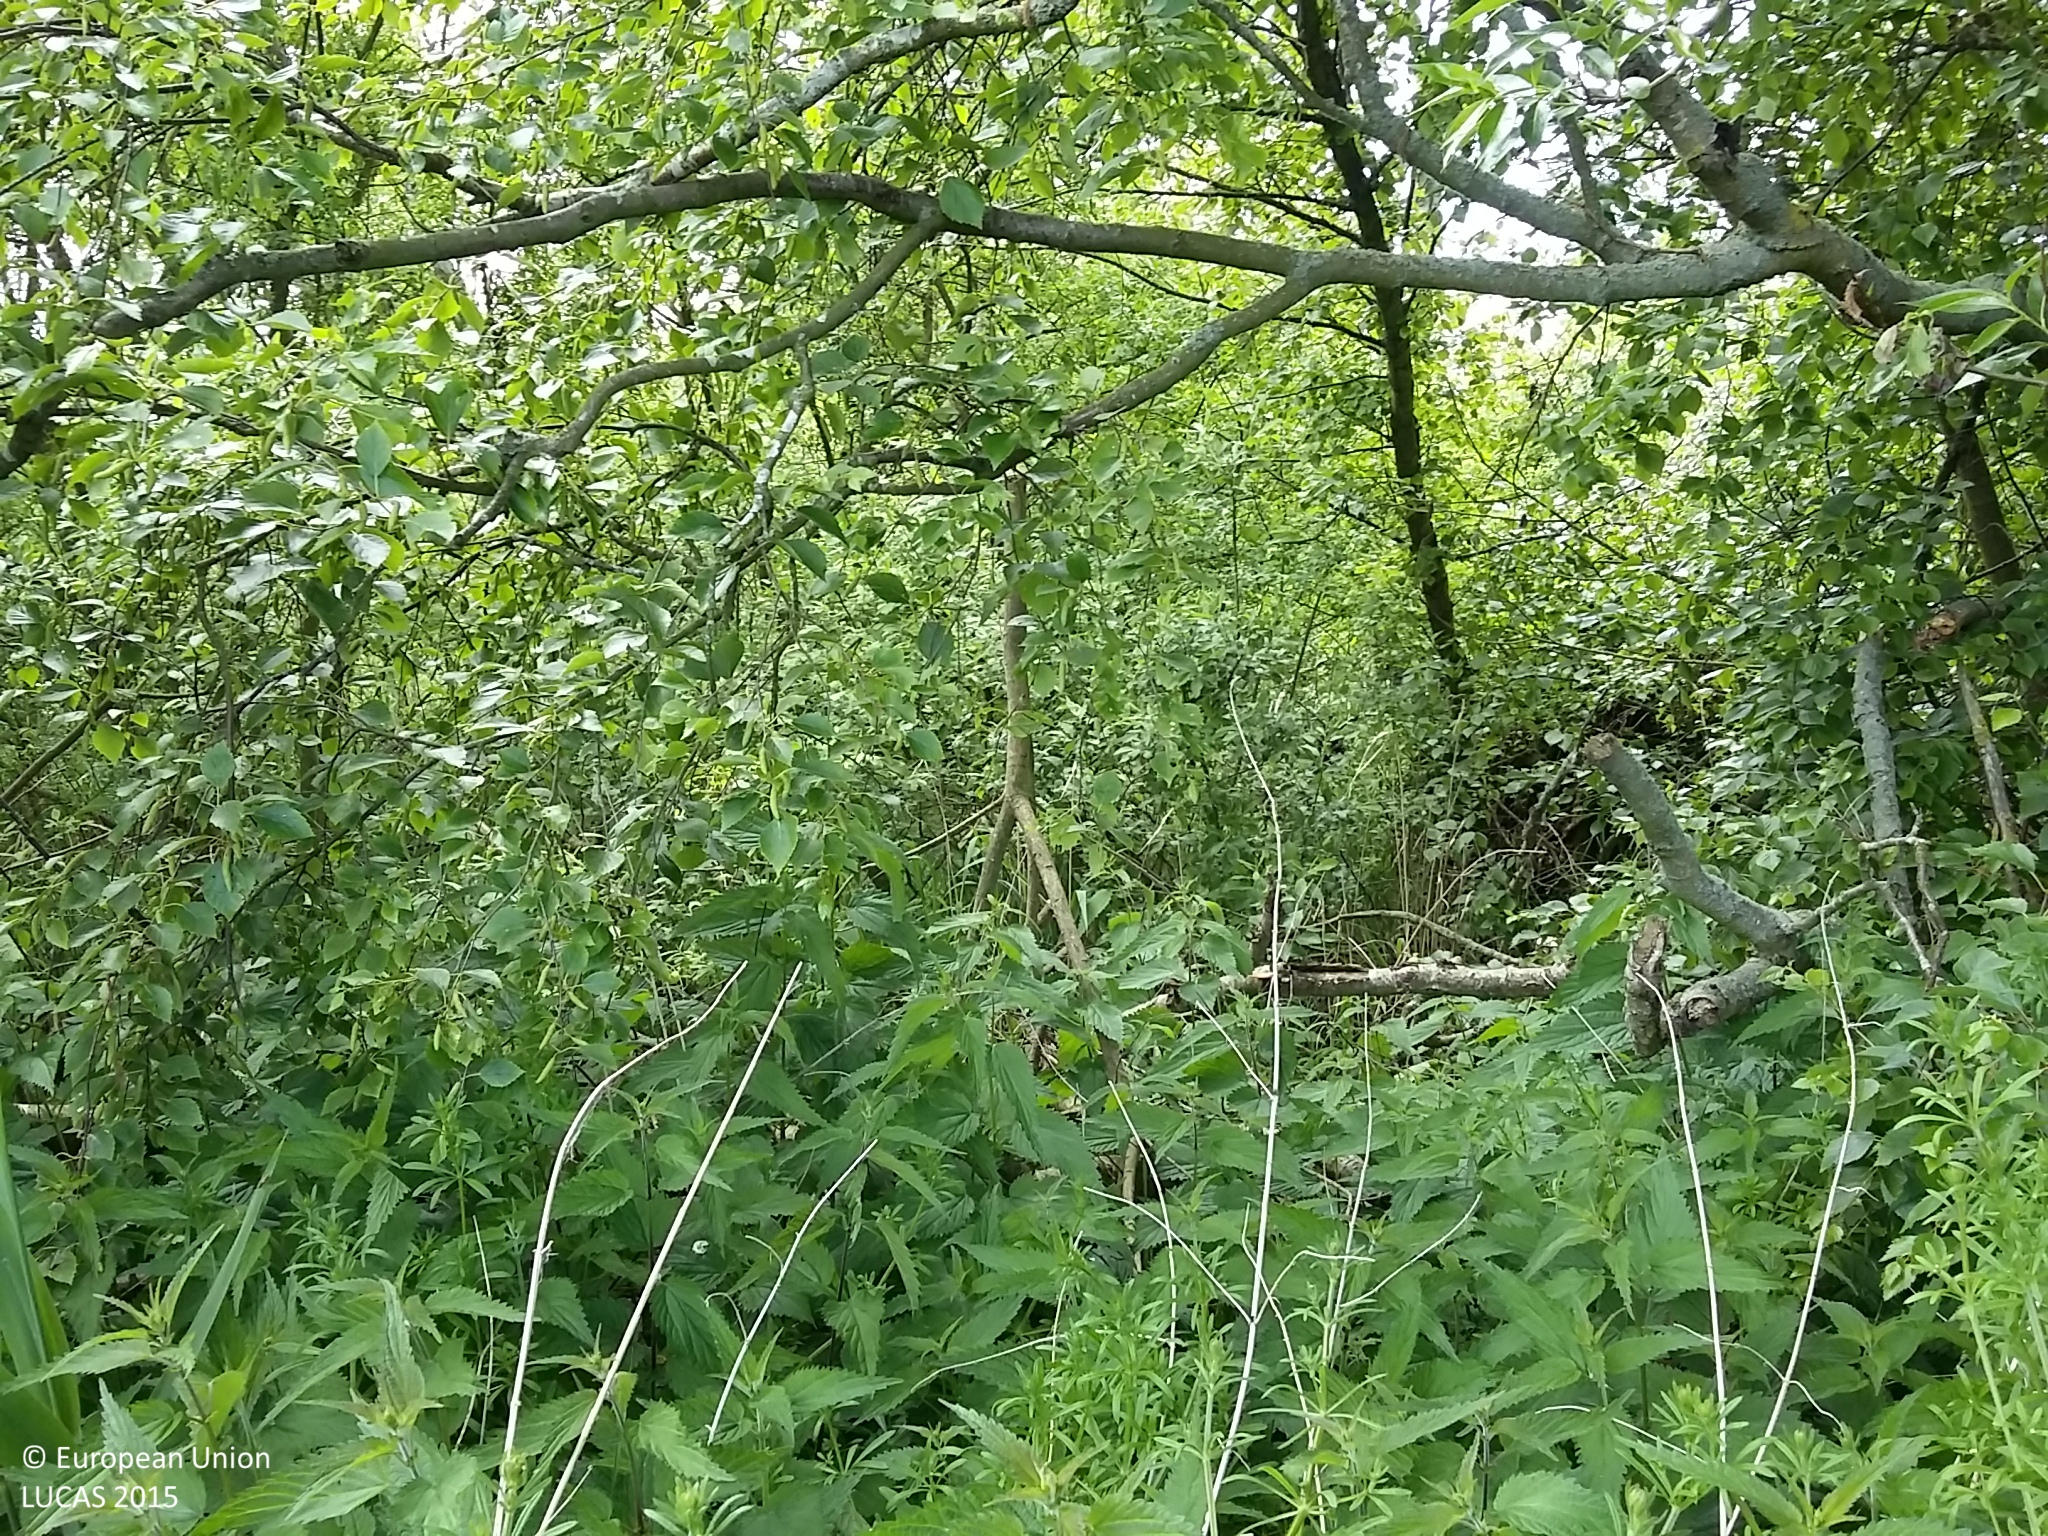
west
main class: Woodland
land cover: Broadleaved woodland
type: mesophytic deciduous forest
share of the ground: > 75 %
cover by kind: broadleaved forest trees 80 %, herbaceous plants 20 %
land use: Semi-natural and natural areas not in use
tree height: > 5 m
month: June
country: DK
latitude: 54.8555
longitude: 10.7316
